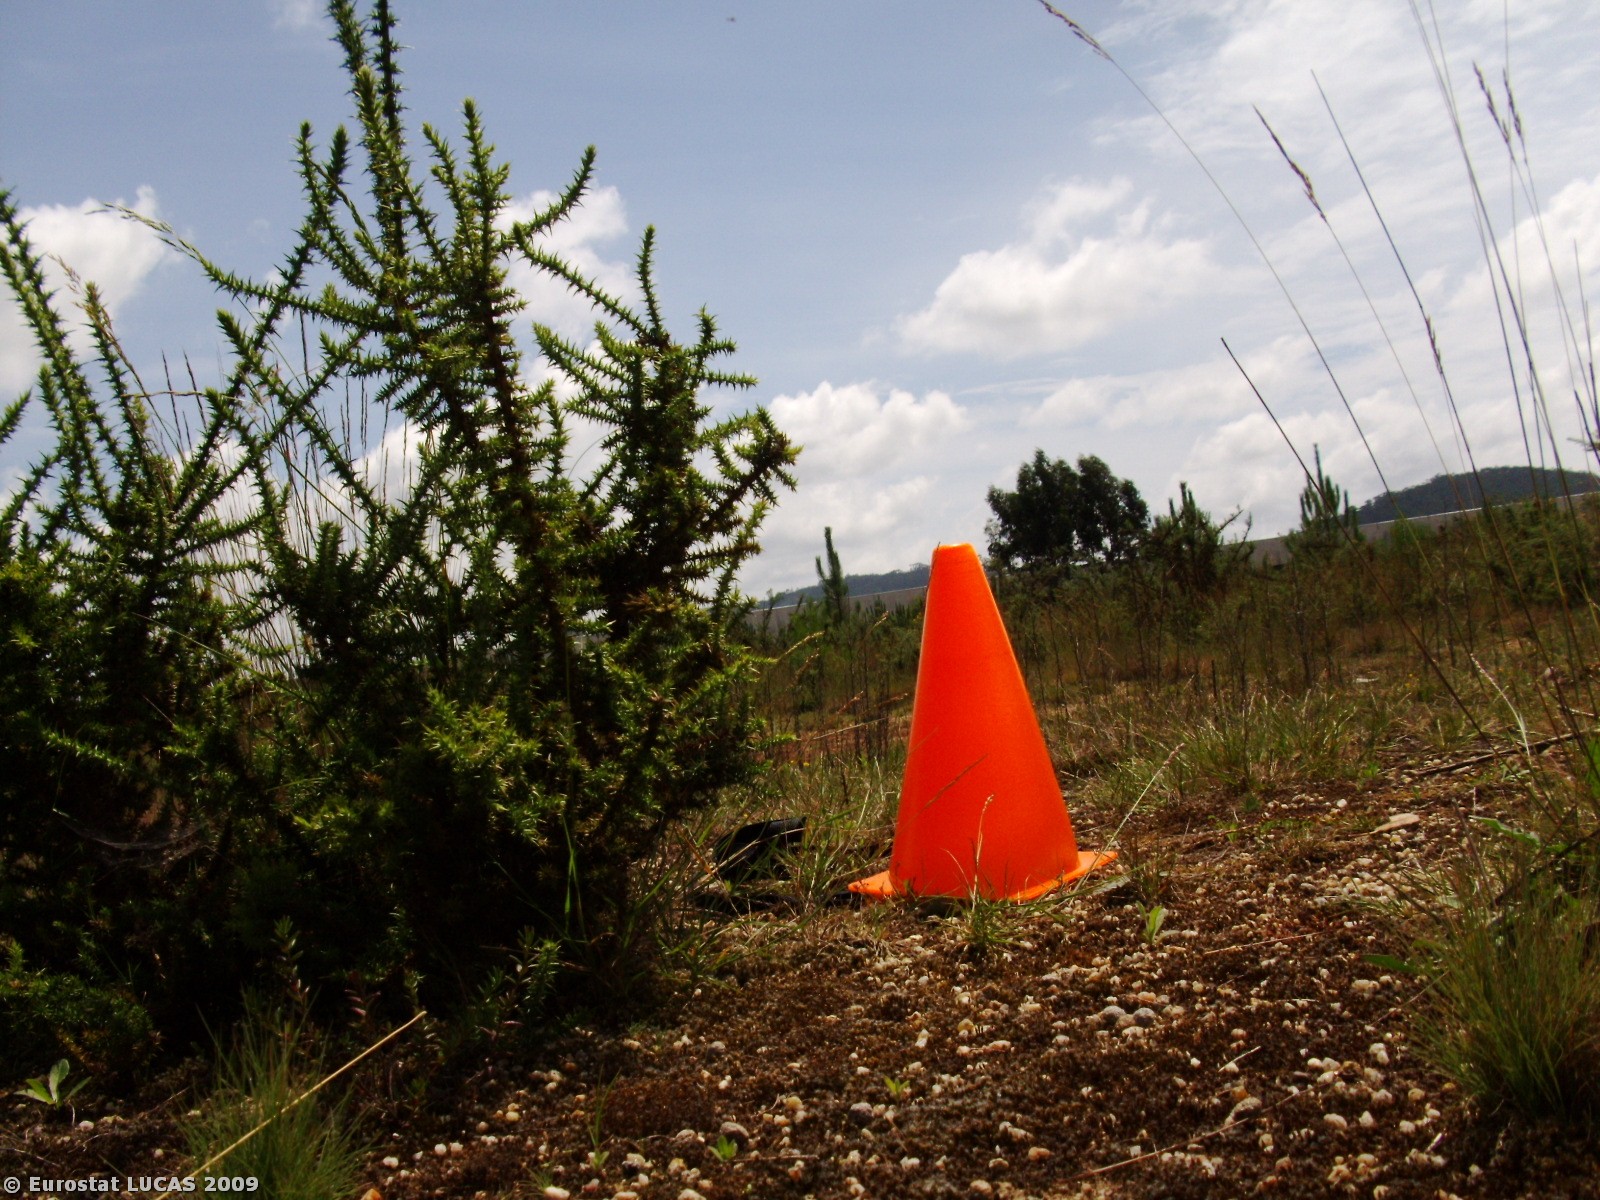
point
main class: Grassland
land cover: Spontaneously vegetated surfaces
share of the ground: 10 - 25 %
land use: Unused
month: June
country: PT
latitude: 41.5272
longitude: -8.5782
